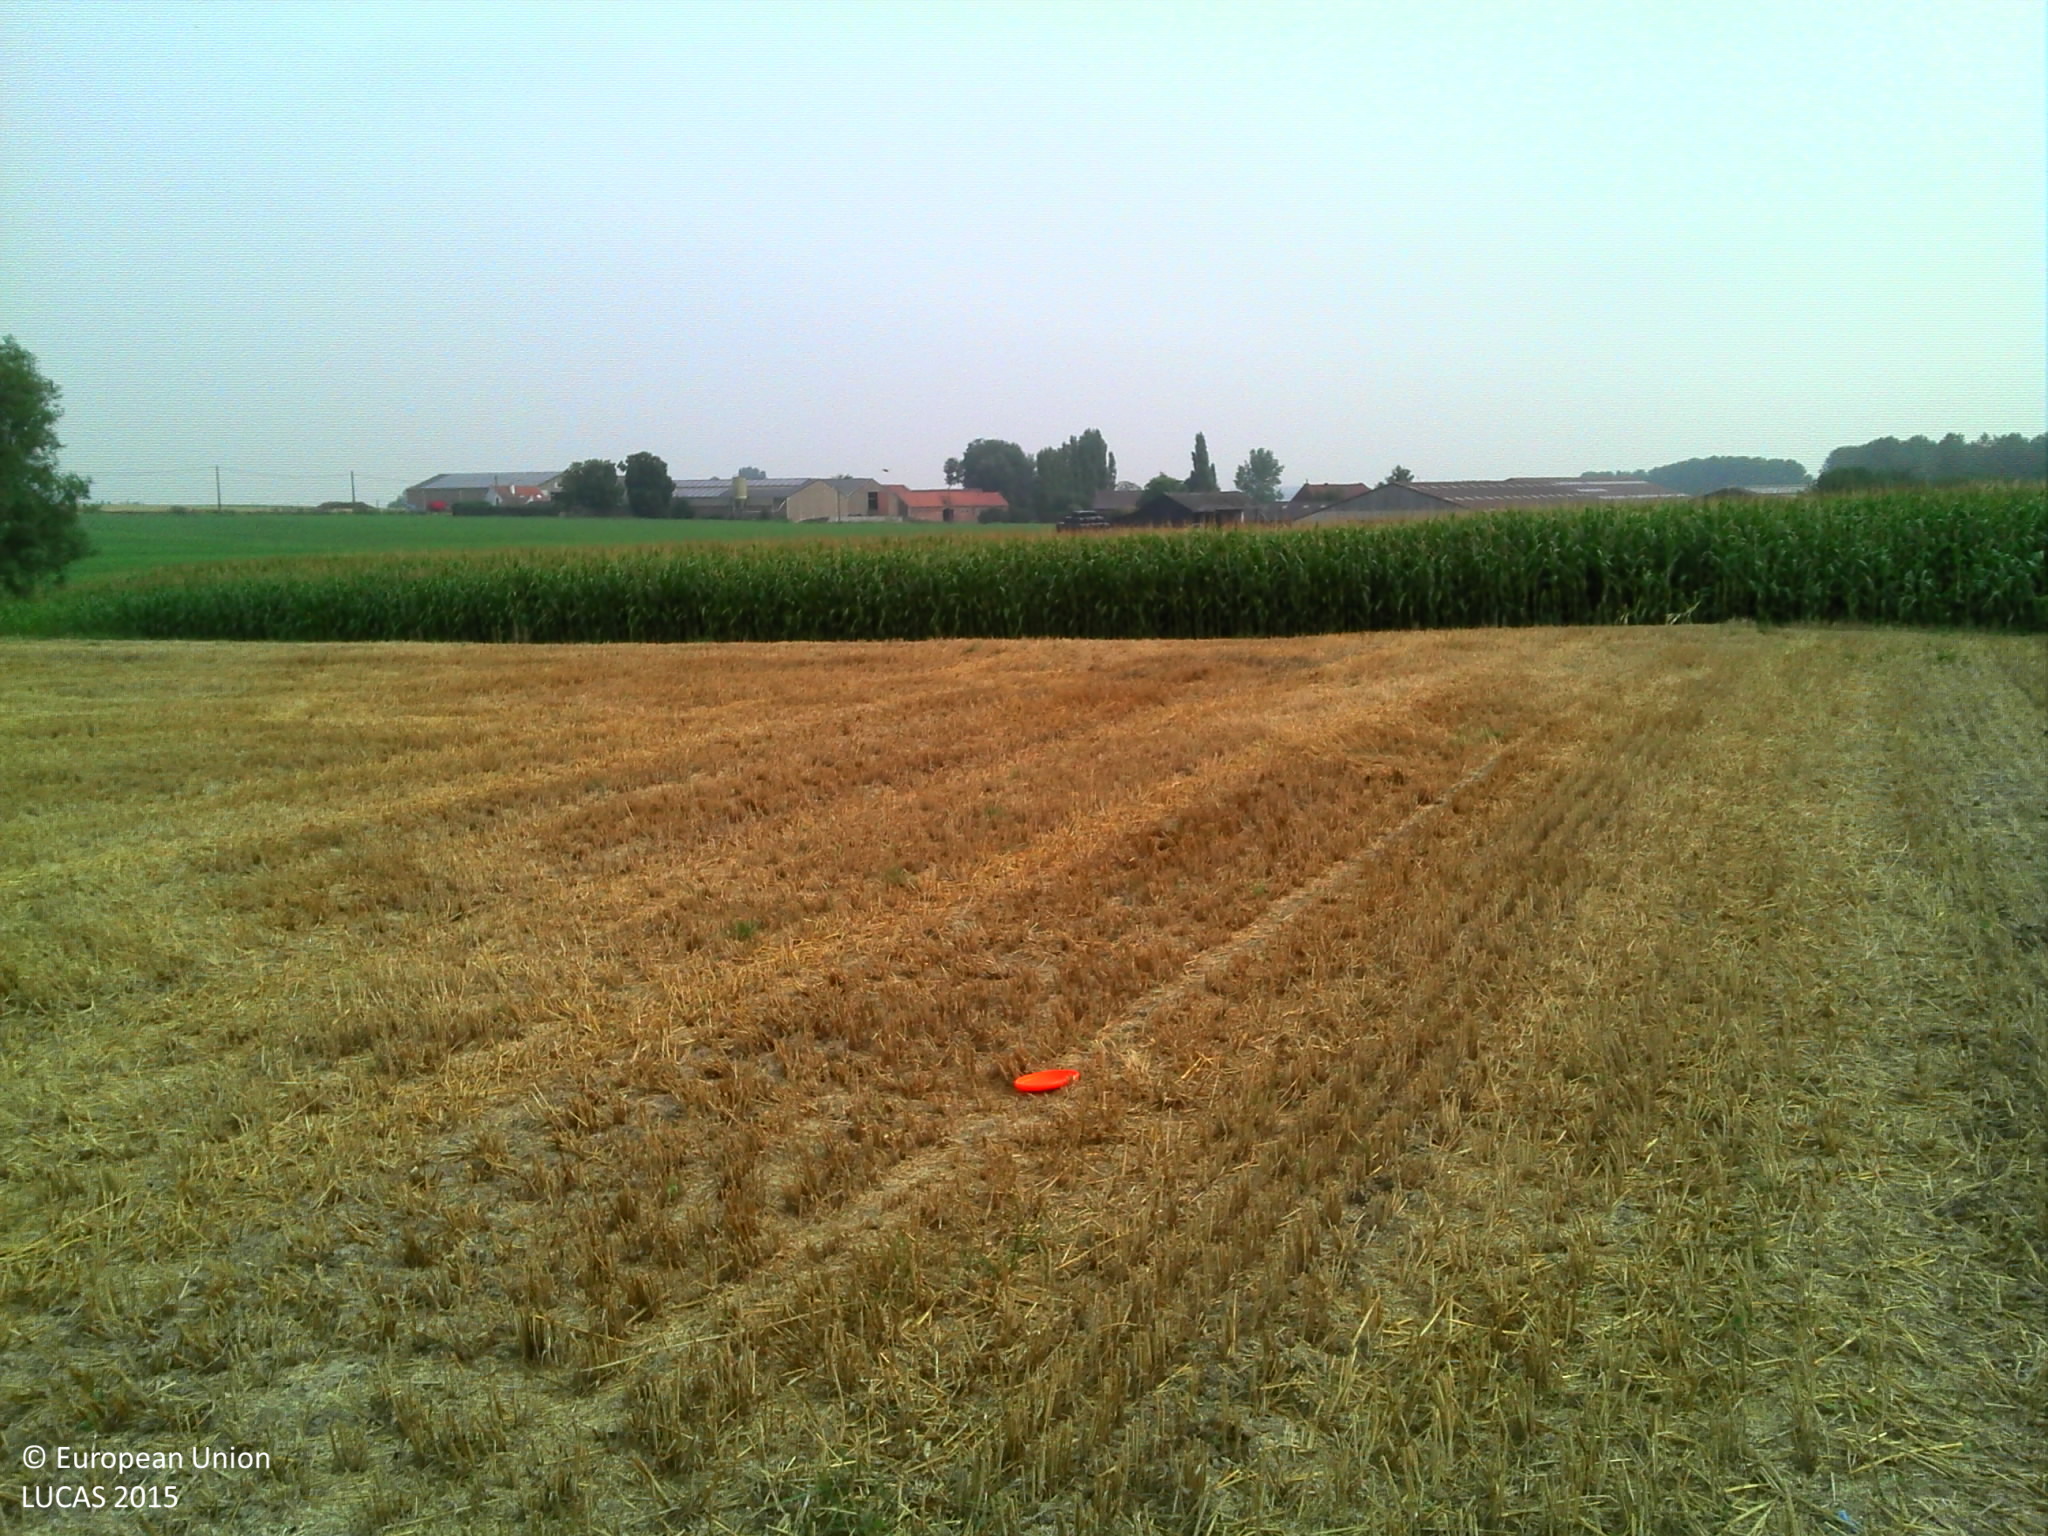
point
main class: Cropland
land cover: Common wheat
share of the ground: > 75 %
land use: Agriculture (excluding fallow land and kitchen gardens)
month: August
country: BE
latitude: 50.6645
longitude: 3.4700
